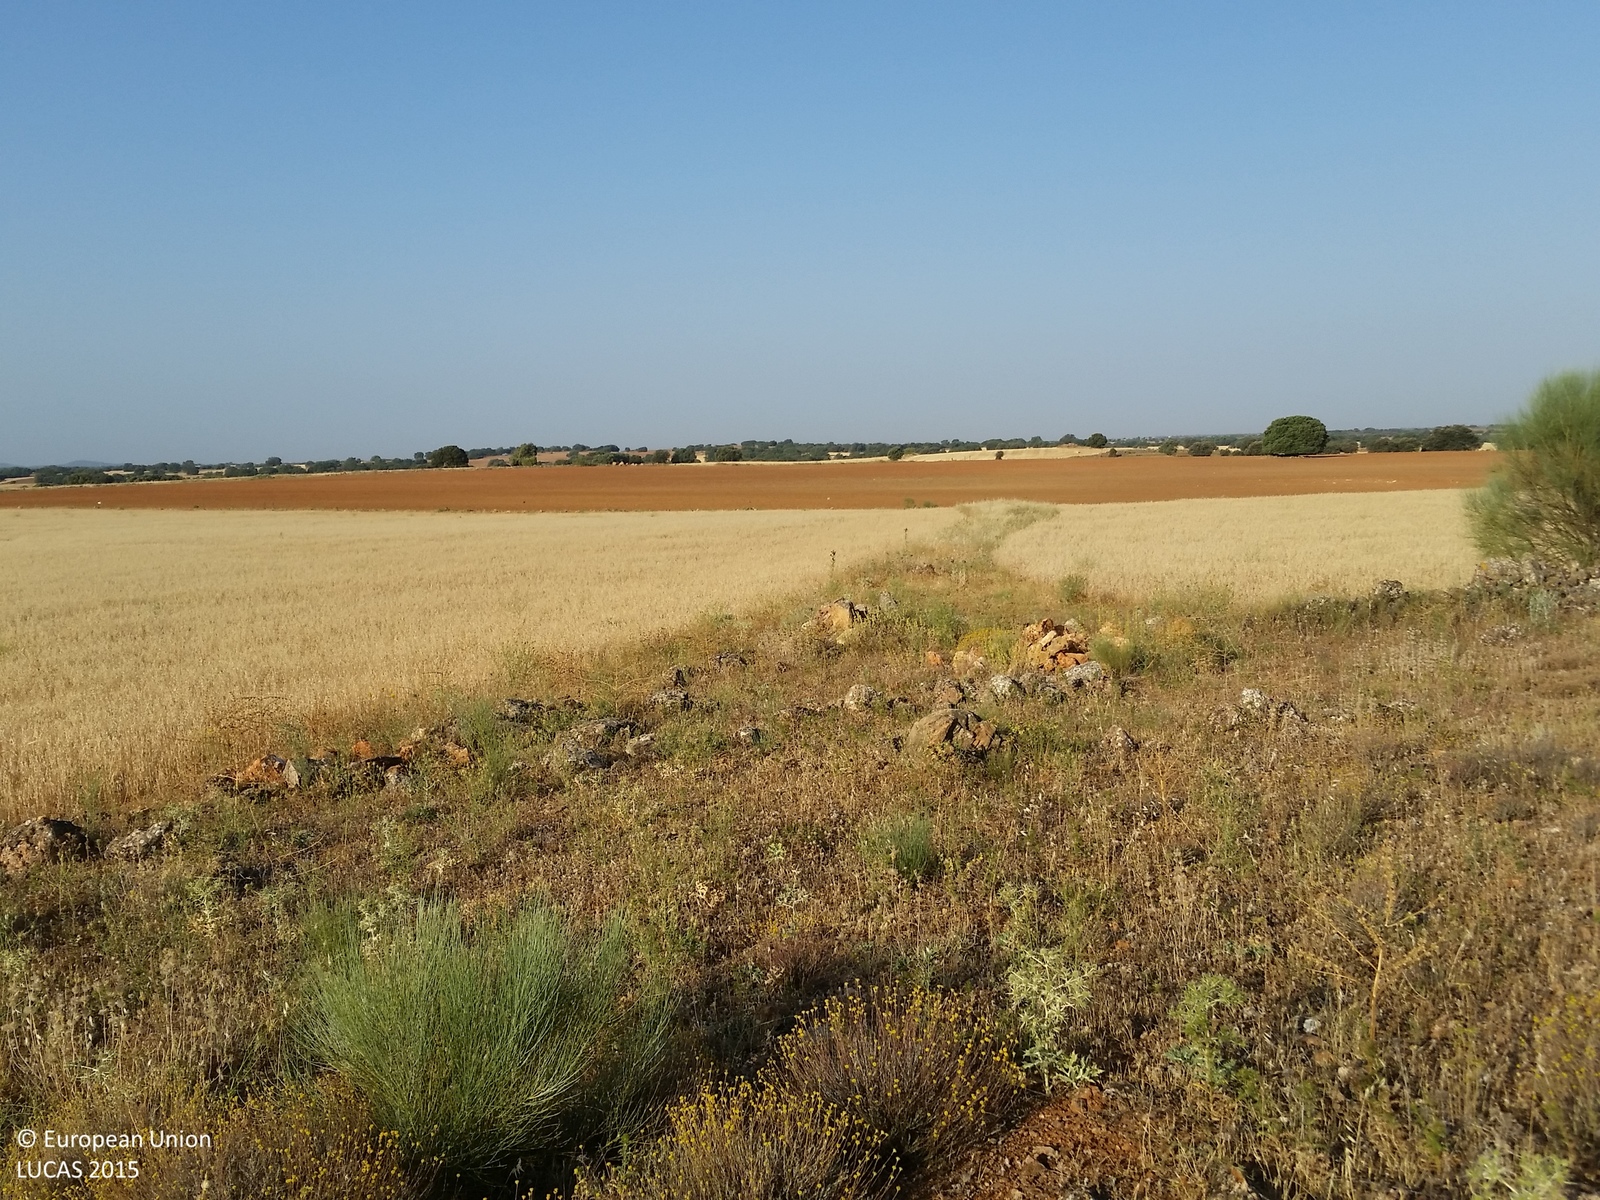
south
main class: Shrubland
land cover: Shrubland without tree cover
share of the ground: > 75 %
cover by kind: shrubs 75 %, herbaceous plants 15 %, consolidated bare surface 10 %
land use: Semi-natural and natural areas not in use
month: June
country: ES
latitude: 38.7854
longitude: -2.6559
